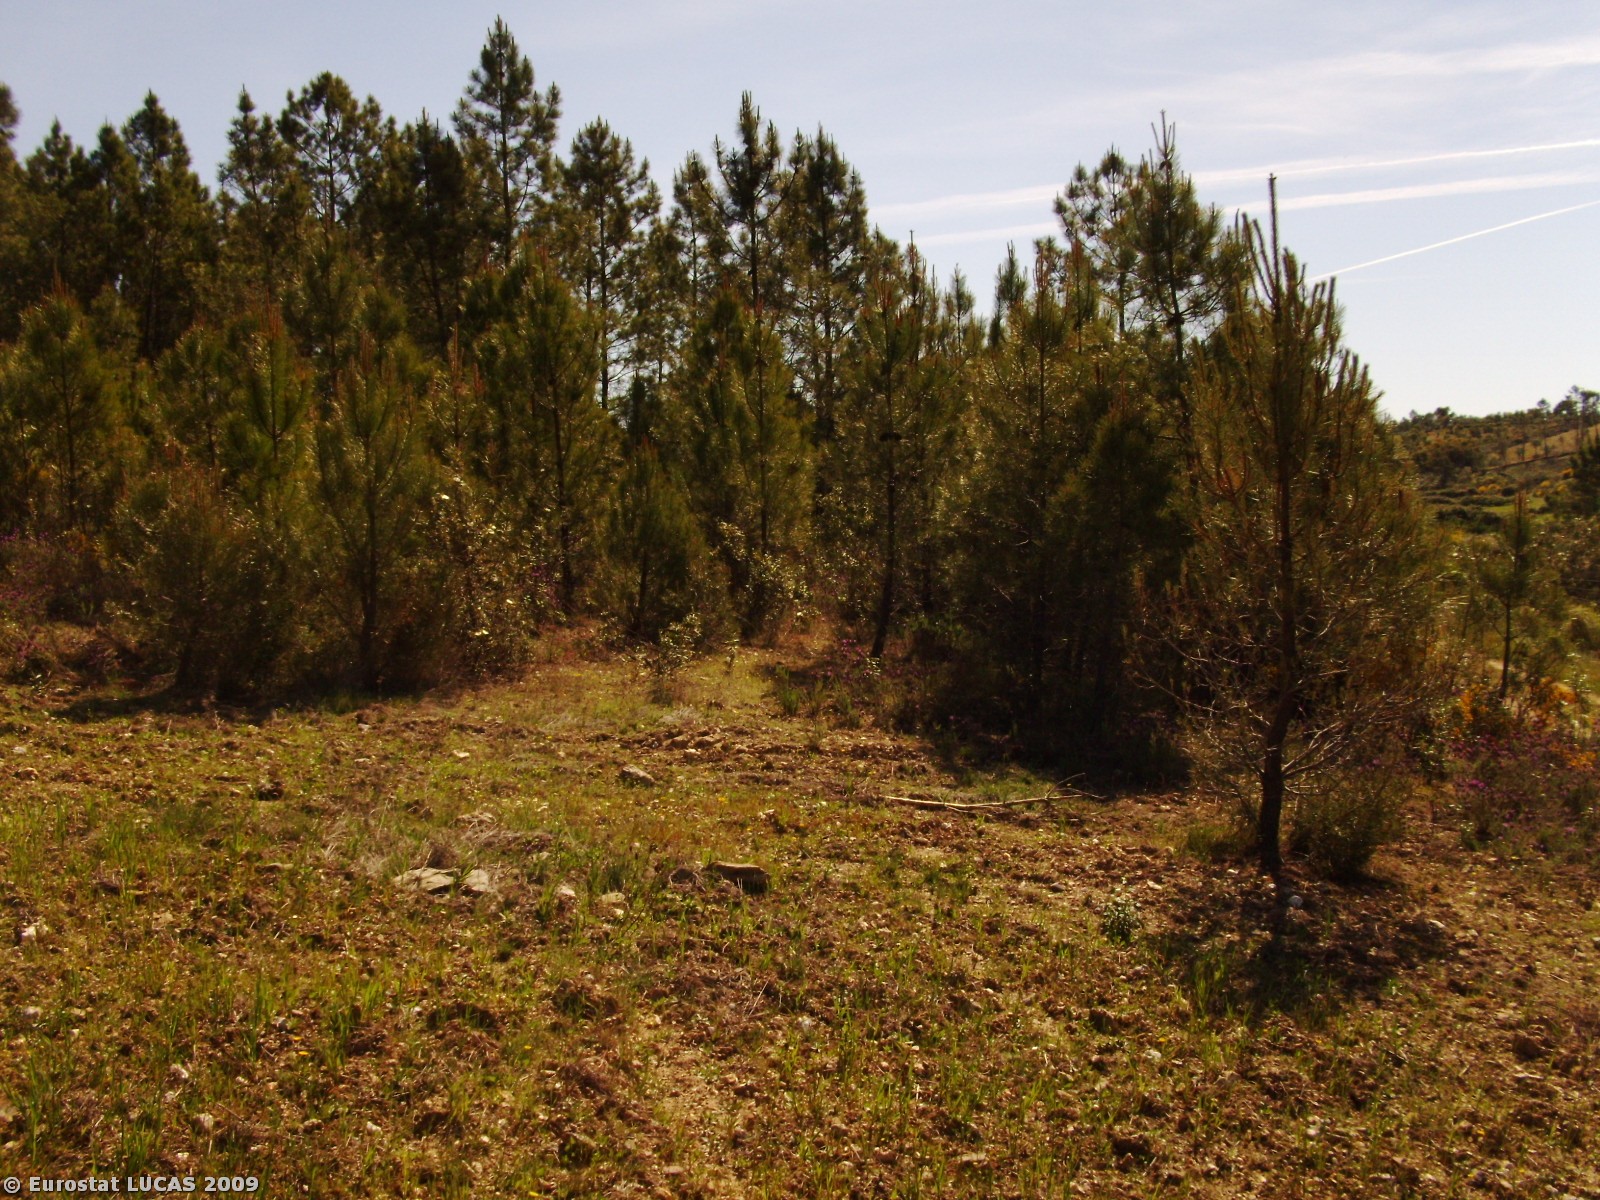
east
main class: Cropland
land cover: Oats
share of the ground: 25 - 50 %
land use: Agriculture (excluding fallow land and kitchen gardens)
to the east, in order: Oats; Coniferous woodland; Fences; Tracks; Dry stone walls; Shrubland with sparse tree cover; Dry stone walls; Spontaneously vegetated surfaces; Shrubland with sparse tree cover; Olive groves; Dry stone walls; Spontaneously vegetated surfaces; Dry stone walls
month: May
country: PT
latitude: 39.7523
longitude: -7.5954
